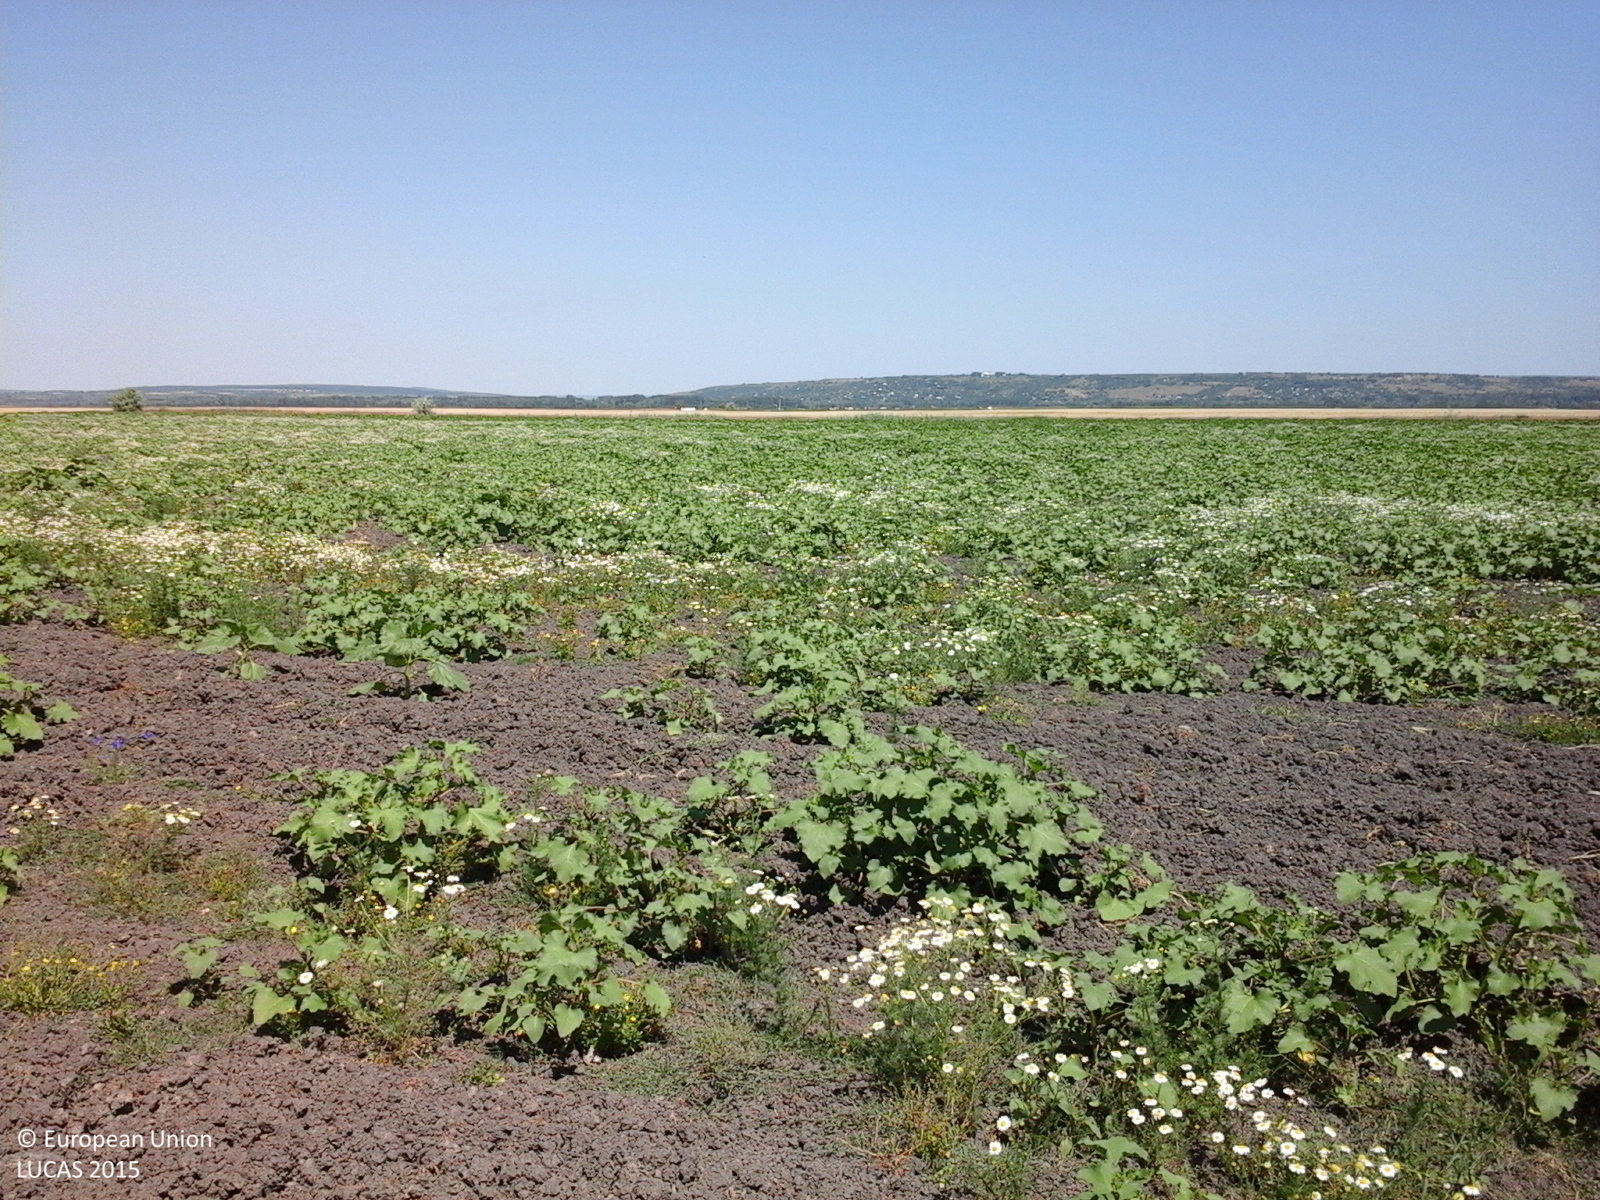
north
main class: Cropland
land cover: Other fresh vegetables
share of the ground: 50 - 75 %
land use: Agriculture (excluding fallow land and kitchen gardens)
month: June
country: RO
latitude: 47.0098
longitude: 27.9520
